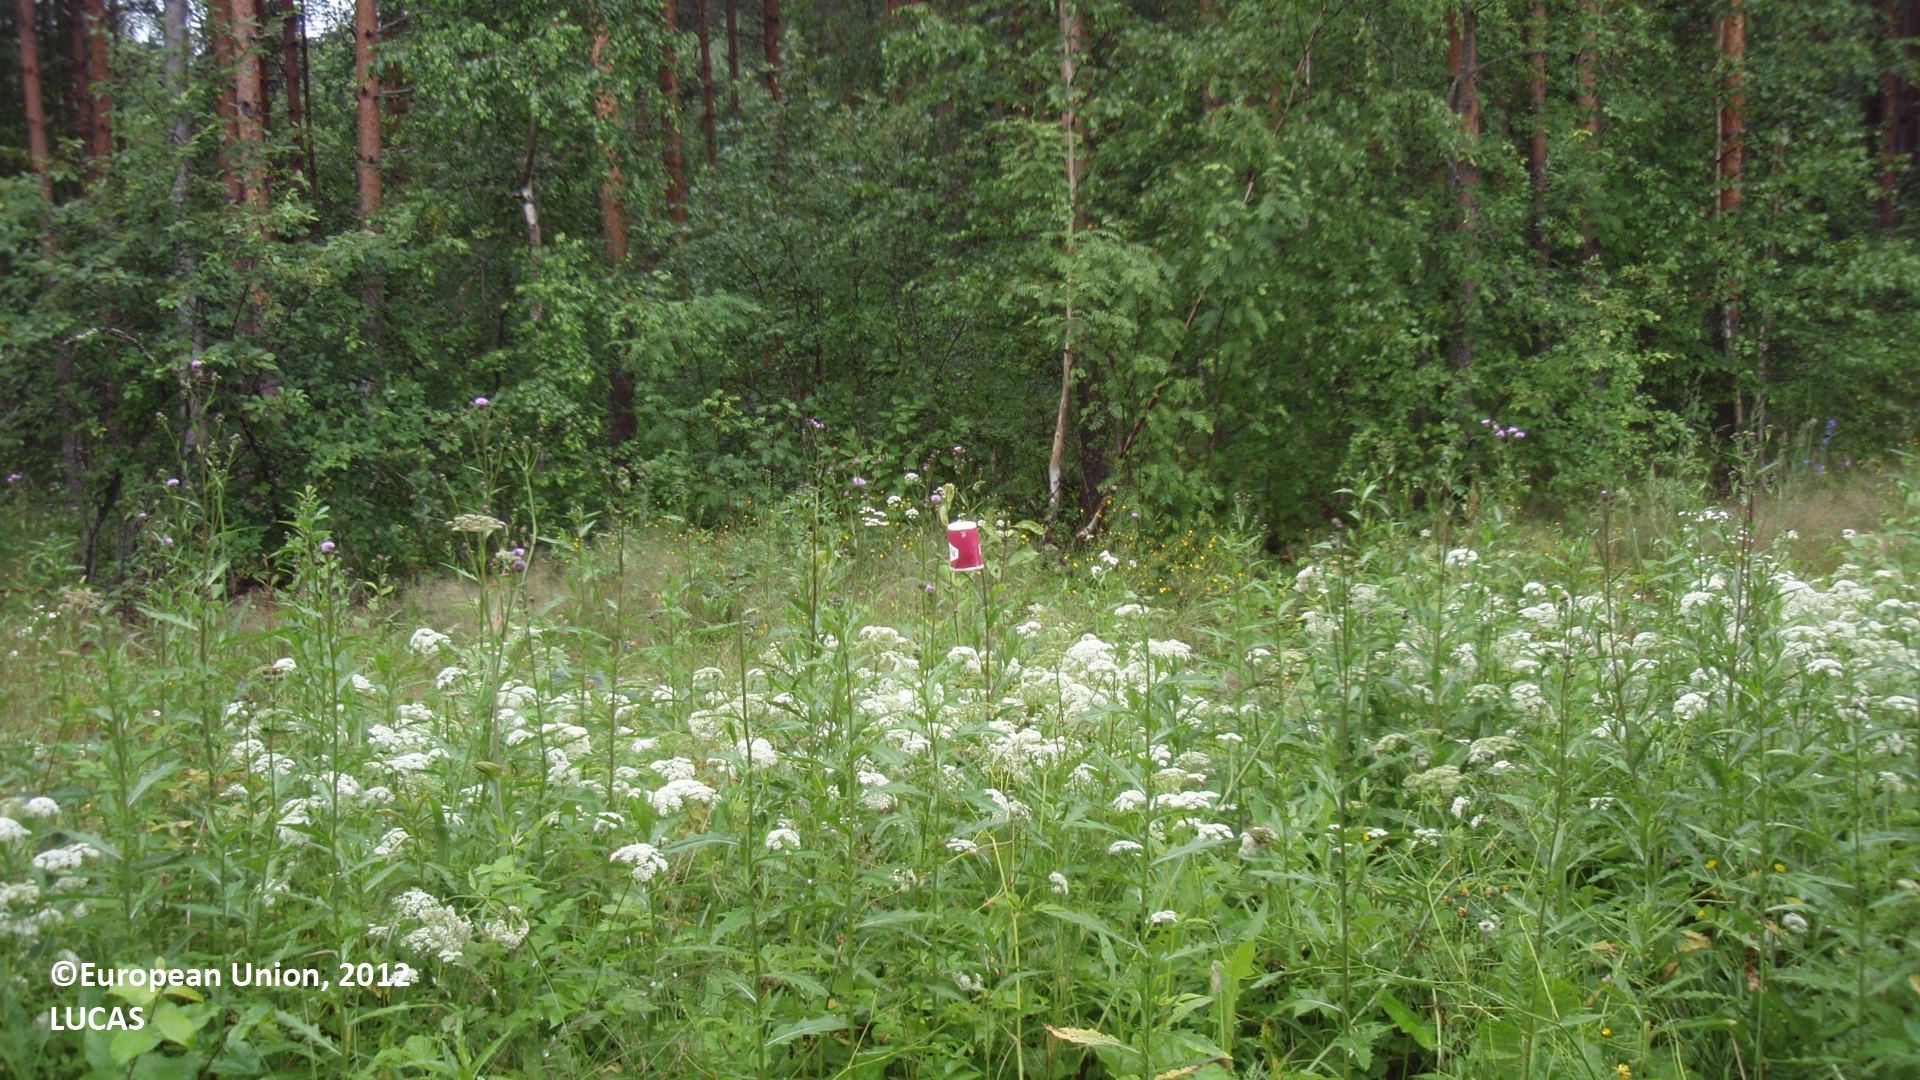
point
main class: Grassland
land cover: Spontaneously vegetated surfaces
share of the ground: > 75 %
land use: Forestry
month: July
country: FI
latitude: 61.1112
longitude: 28.8012
